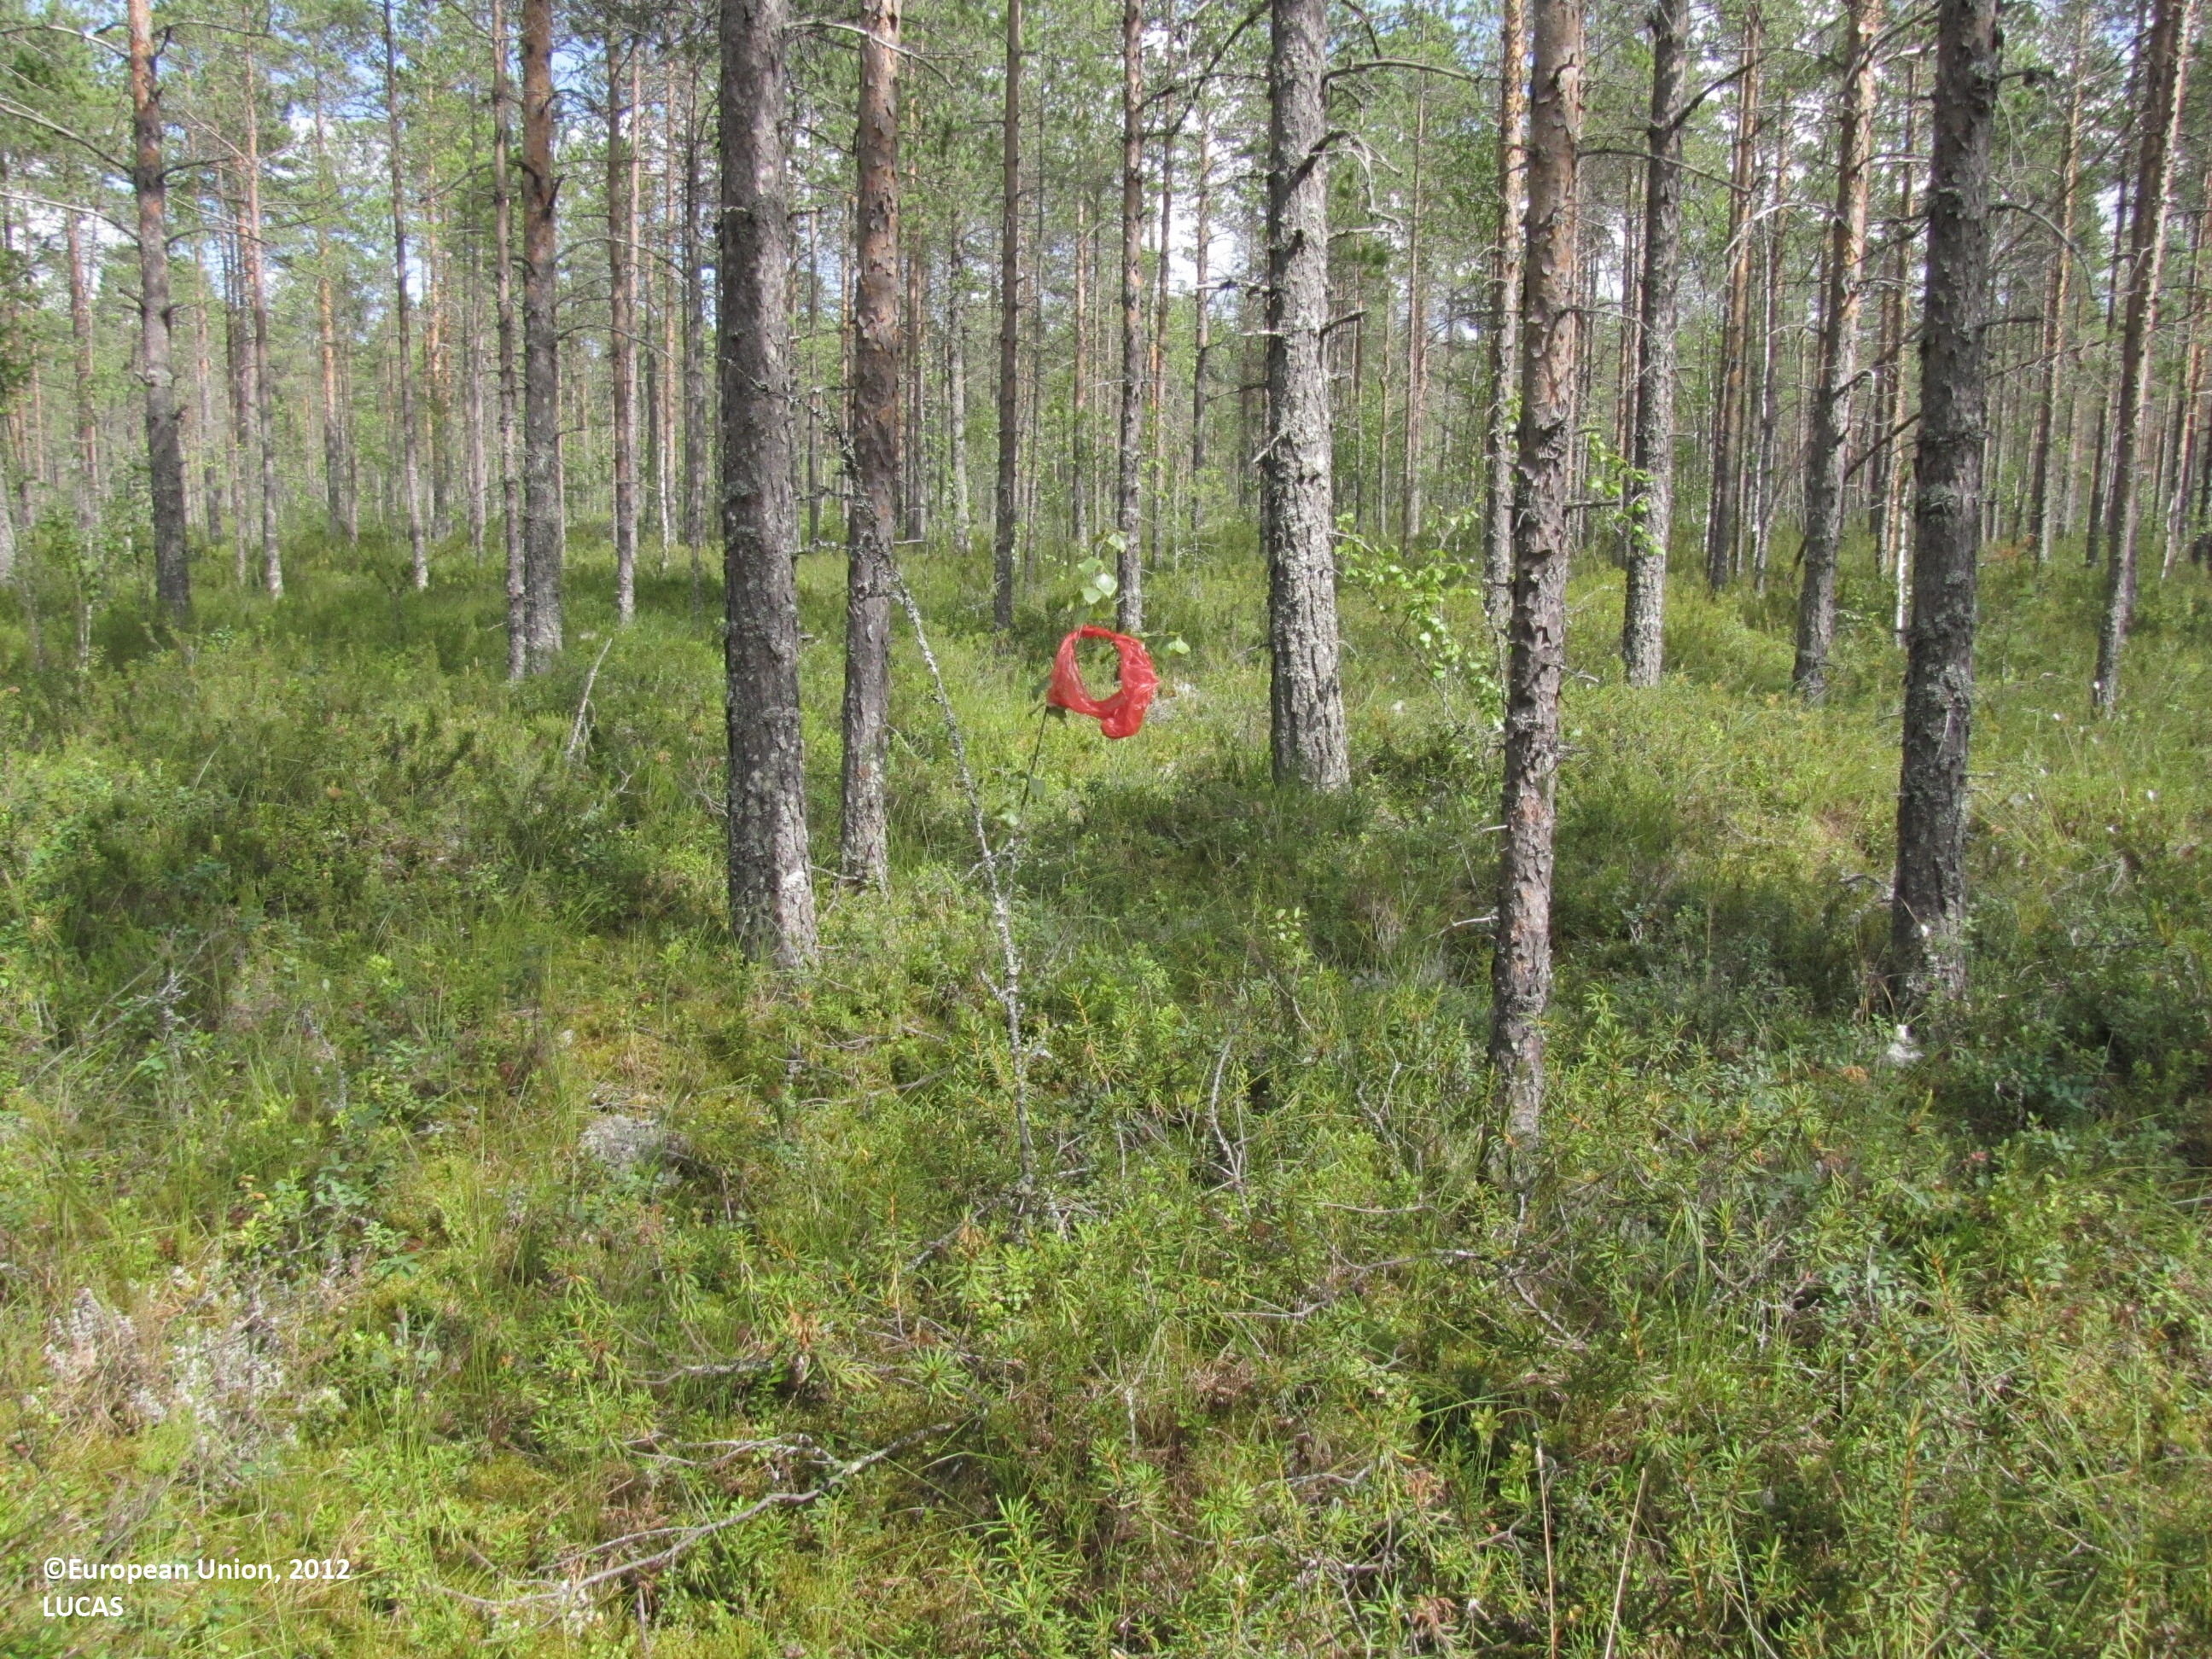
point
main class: Woodland
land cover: Pine dominated coniferous woodland
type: boreal forest
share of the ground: 50 - 75 %
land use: Forestry
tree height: > 5 m
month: July
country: FI
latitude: 62.6306
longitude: 23.2265
